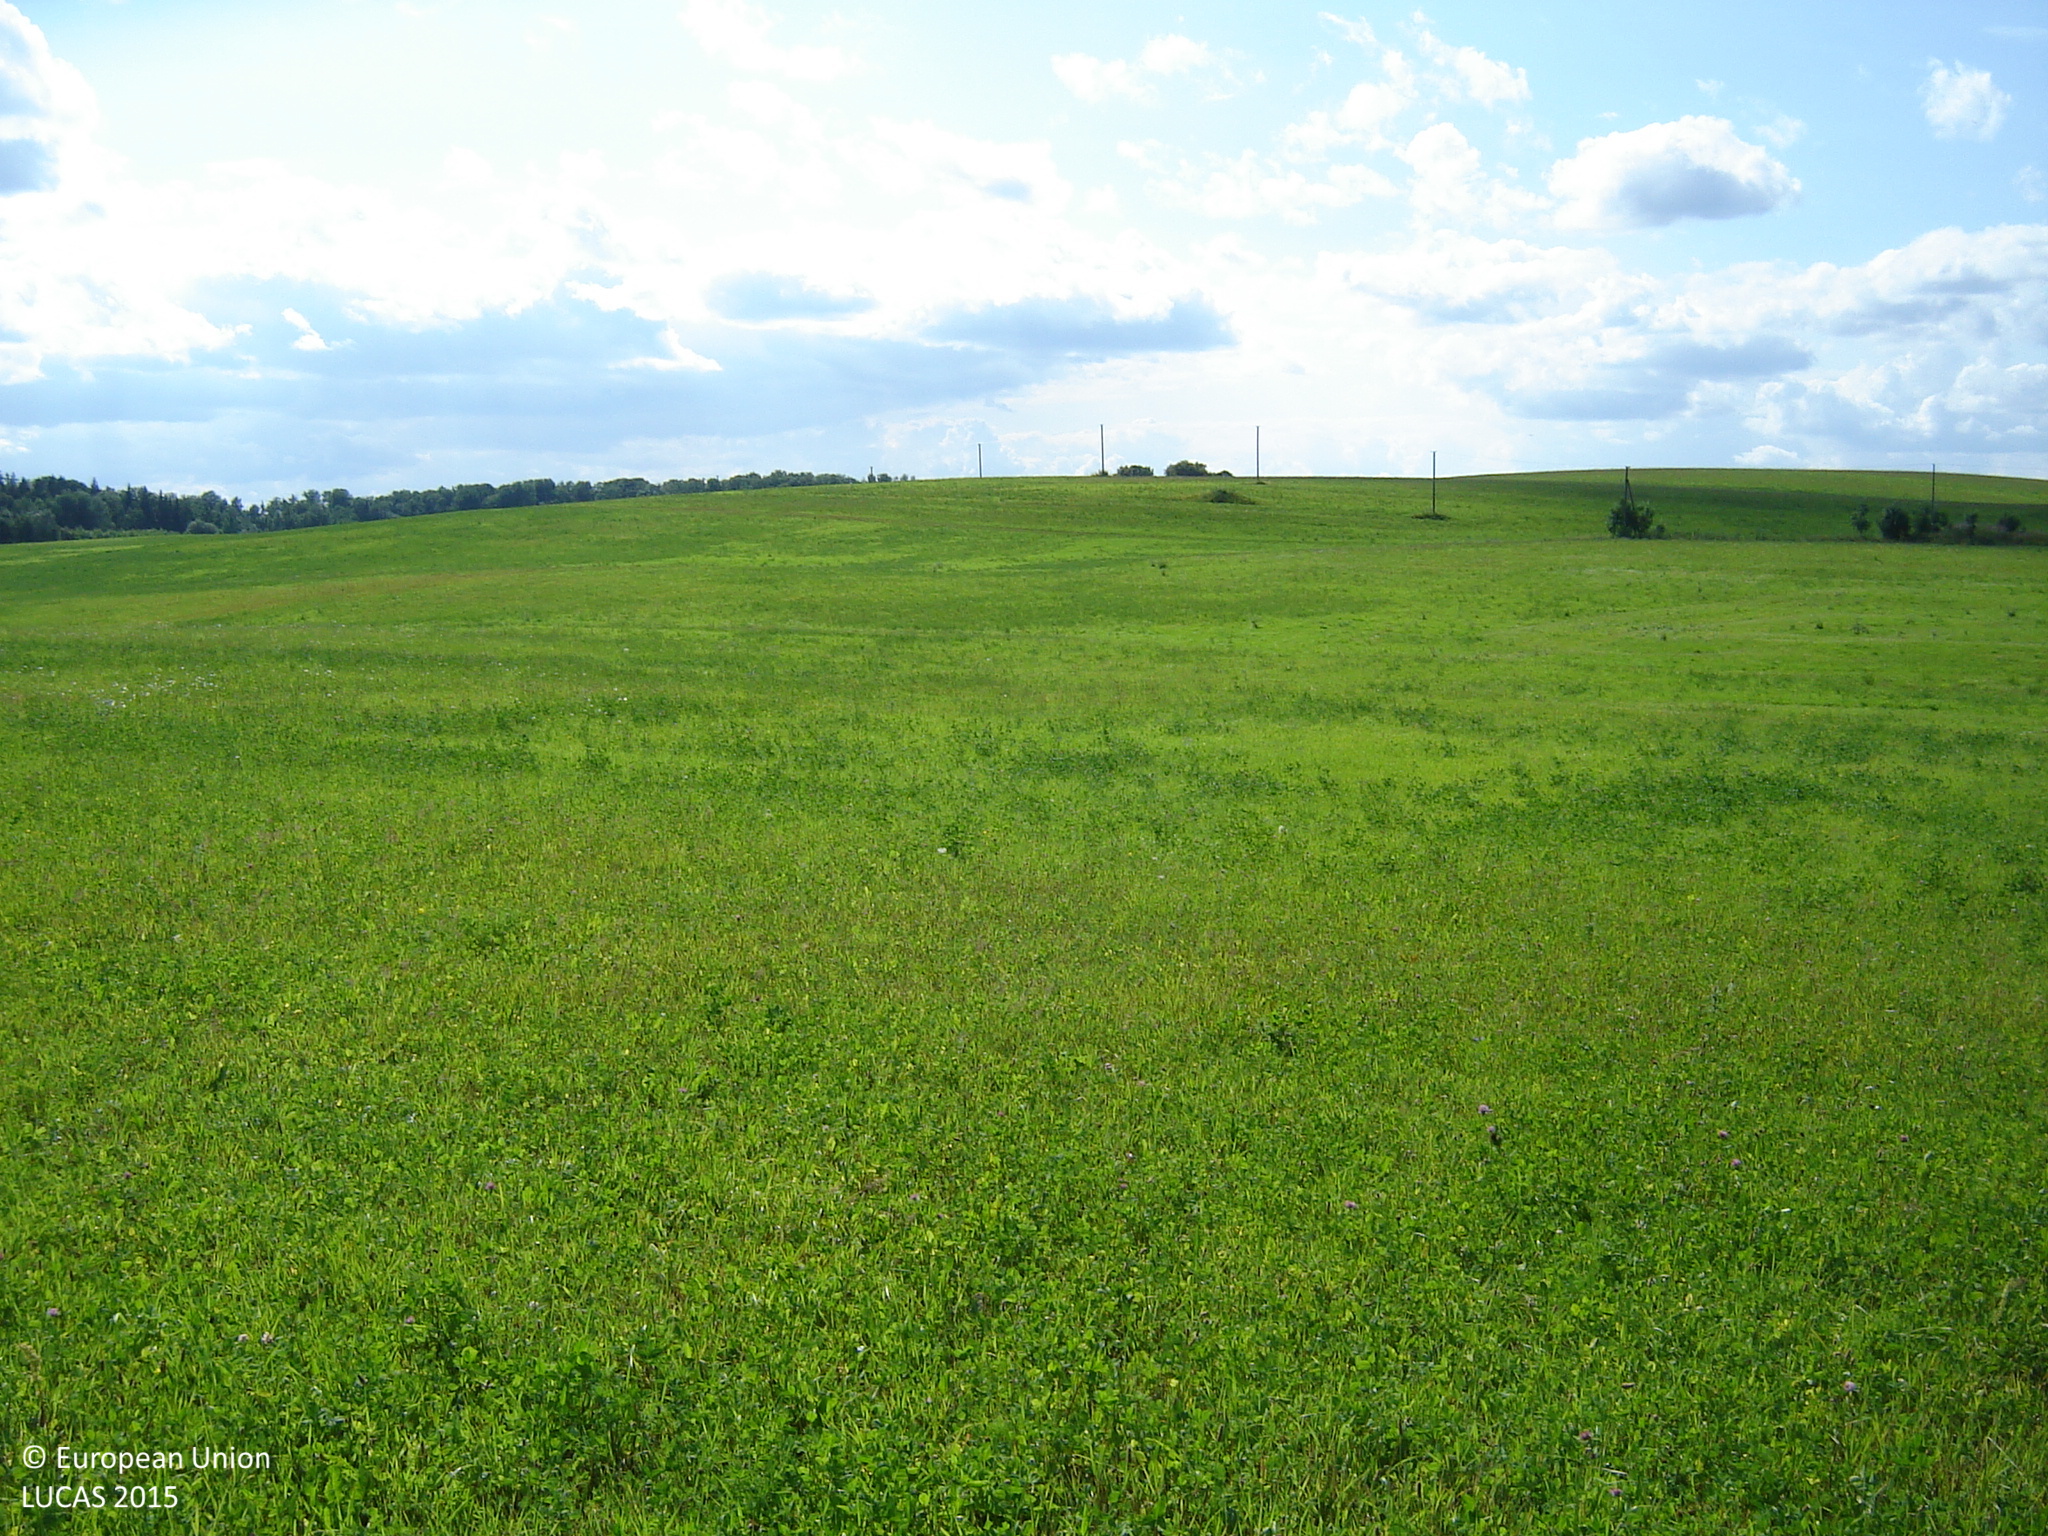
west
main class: Grassland
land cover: Grassland without tree/shrub cover
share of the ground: > 75 %
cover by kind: herbaceous plants 100 %
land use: Agriculture (excluding fallow land and kitchen gardens)
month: July
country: LT
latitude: 55.4905
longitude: 25.2323
